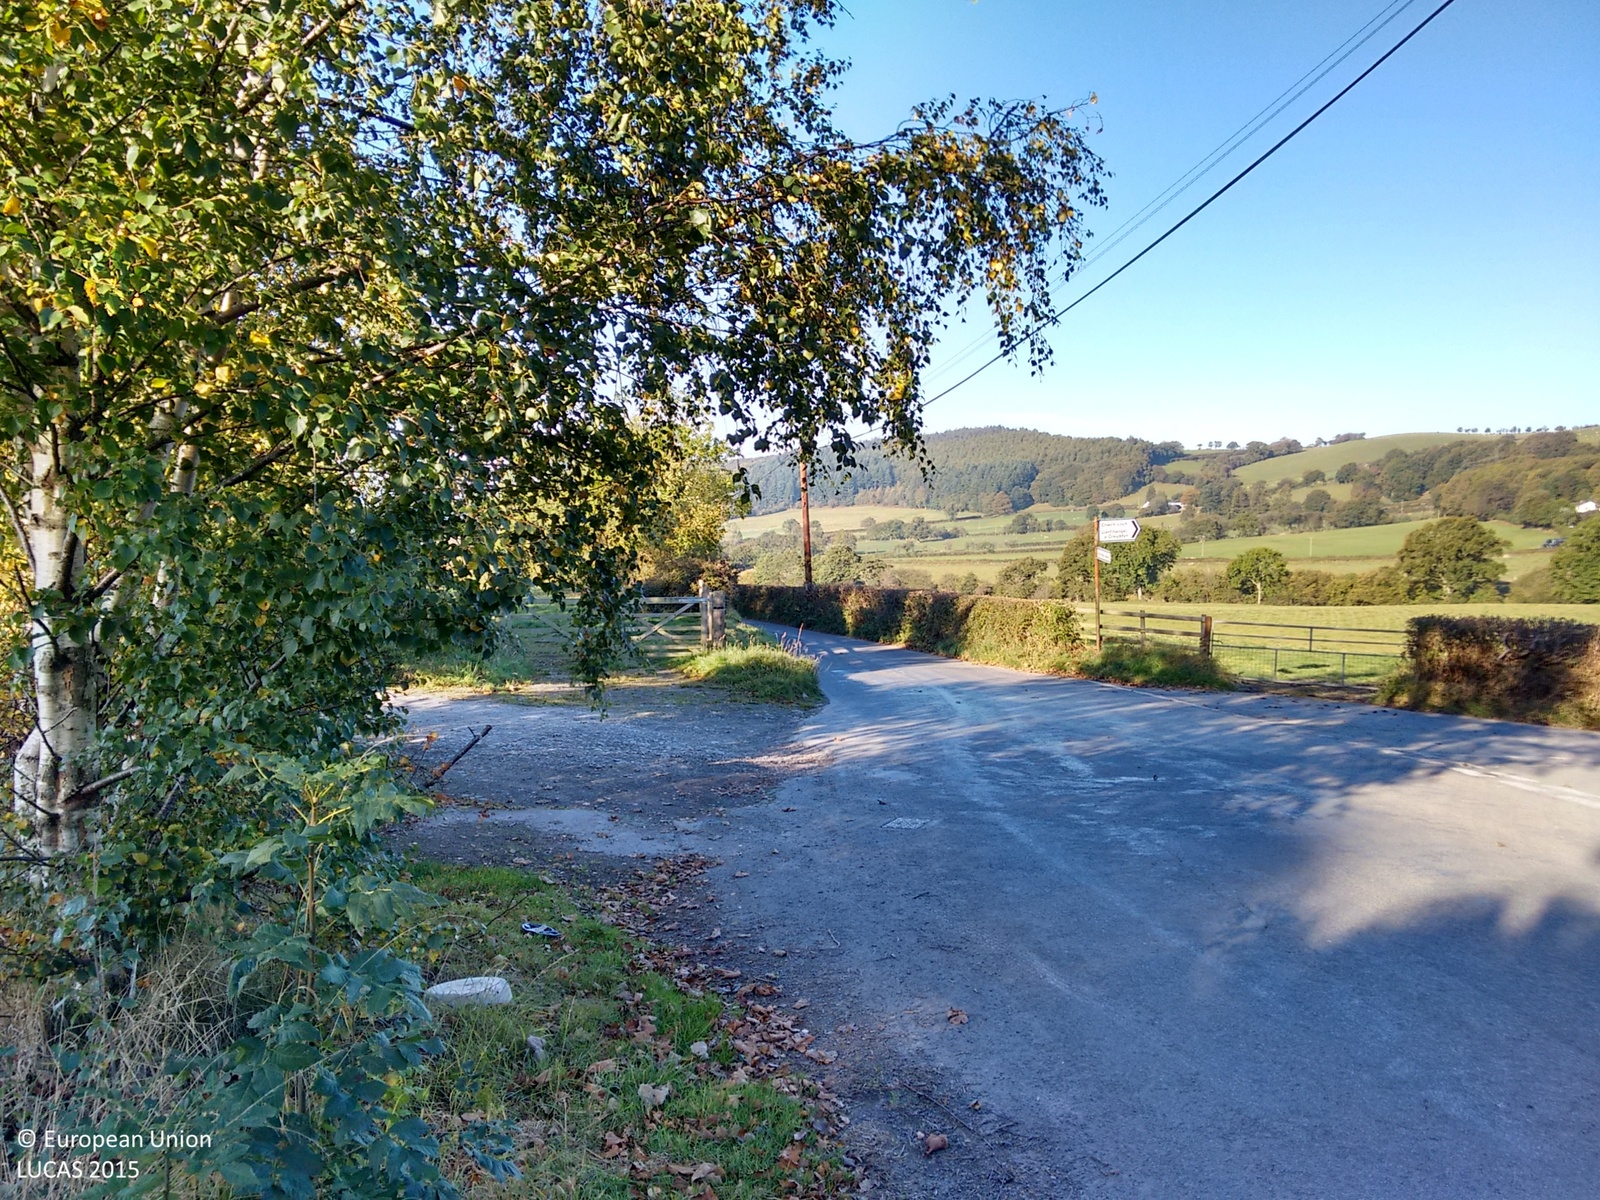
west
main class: Grassland
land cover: Grassland without tree/shrub cover
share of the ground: > 75 %
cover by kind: herbaceous plants 100 %
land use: Agriculture (excluding fallow land and kitchen gardens)
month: October
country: GB
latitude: 52.3531
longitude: -3.9382
